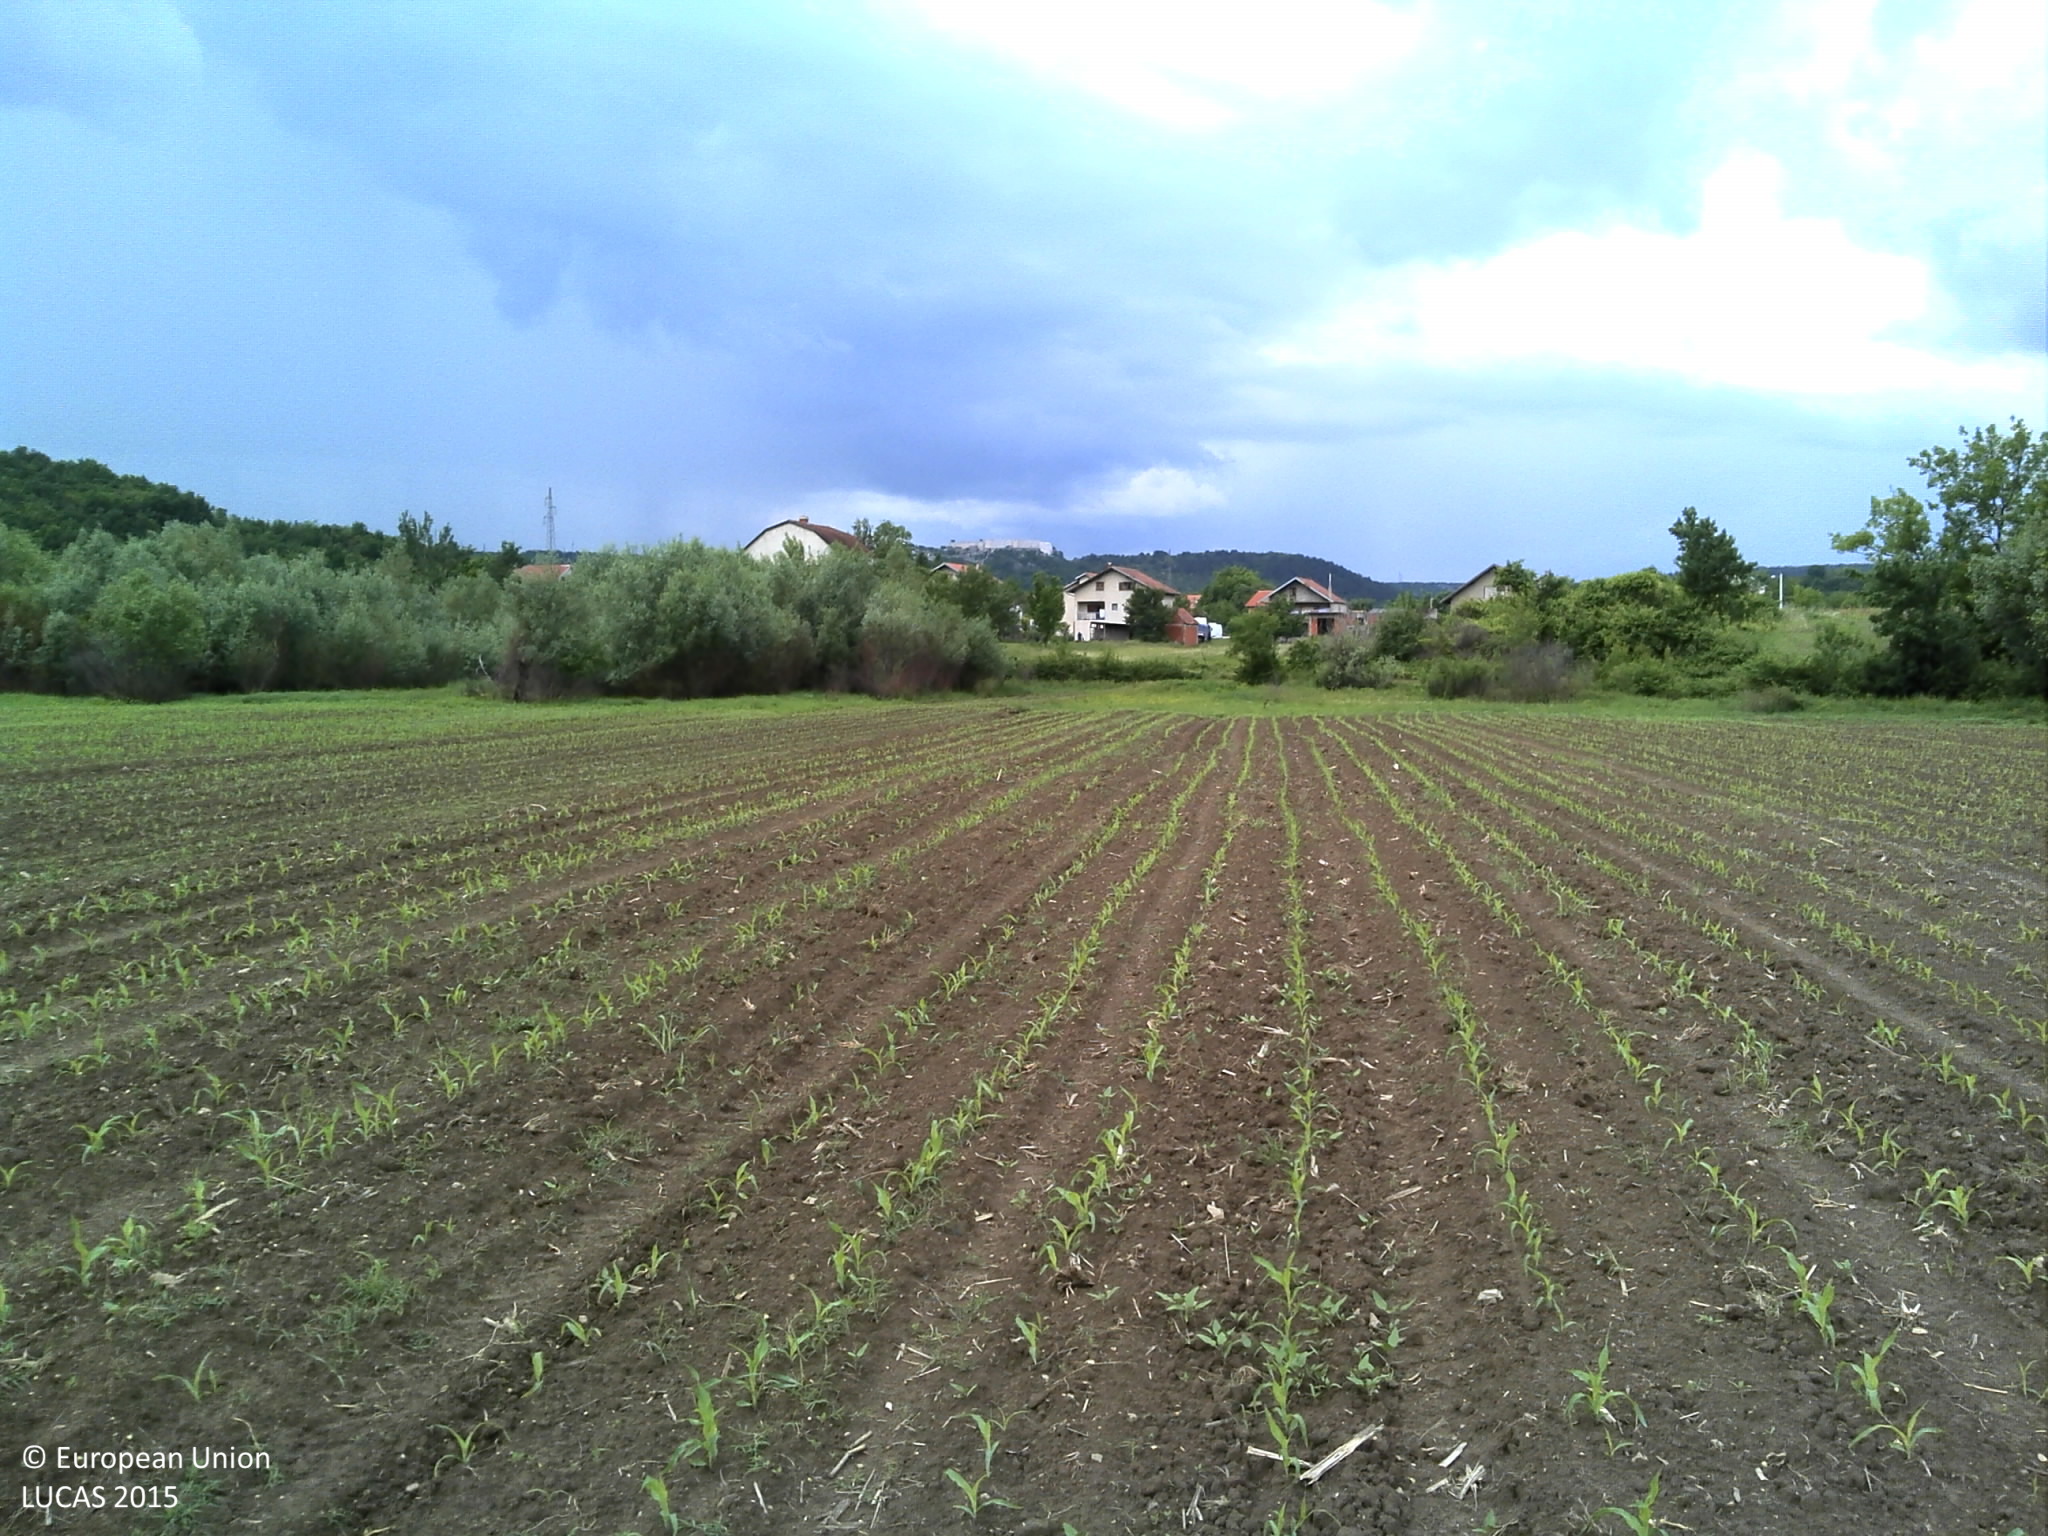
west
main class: Cropland
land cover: Maize
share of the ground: < 10 %
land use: Agriculture (excluding fallow land and kitchen gardens)
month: May
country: HR
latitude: 44.0374
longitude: 16.2194
